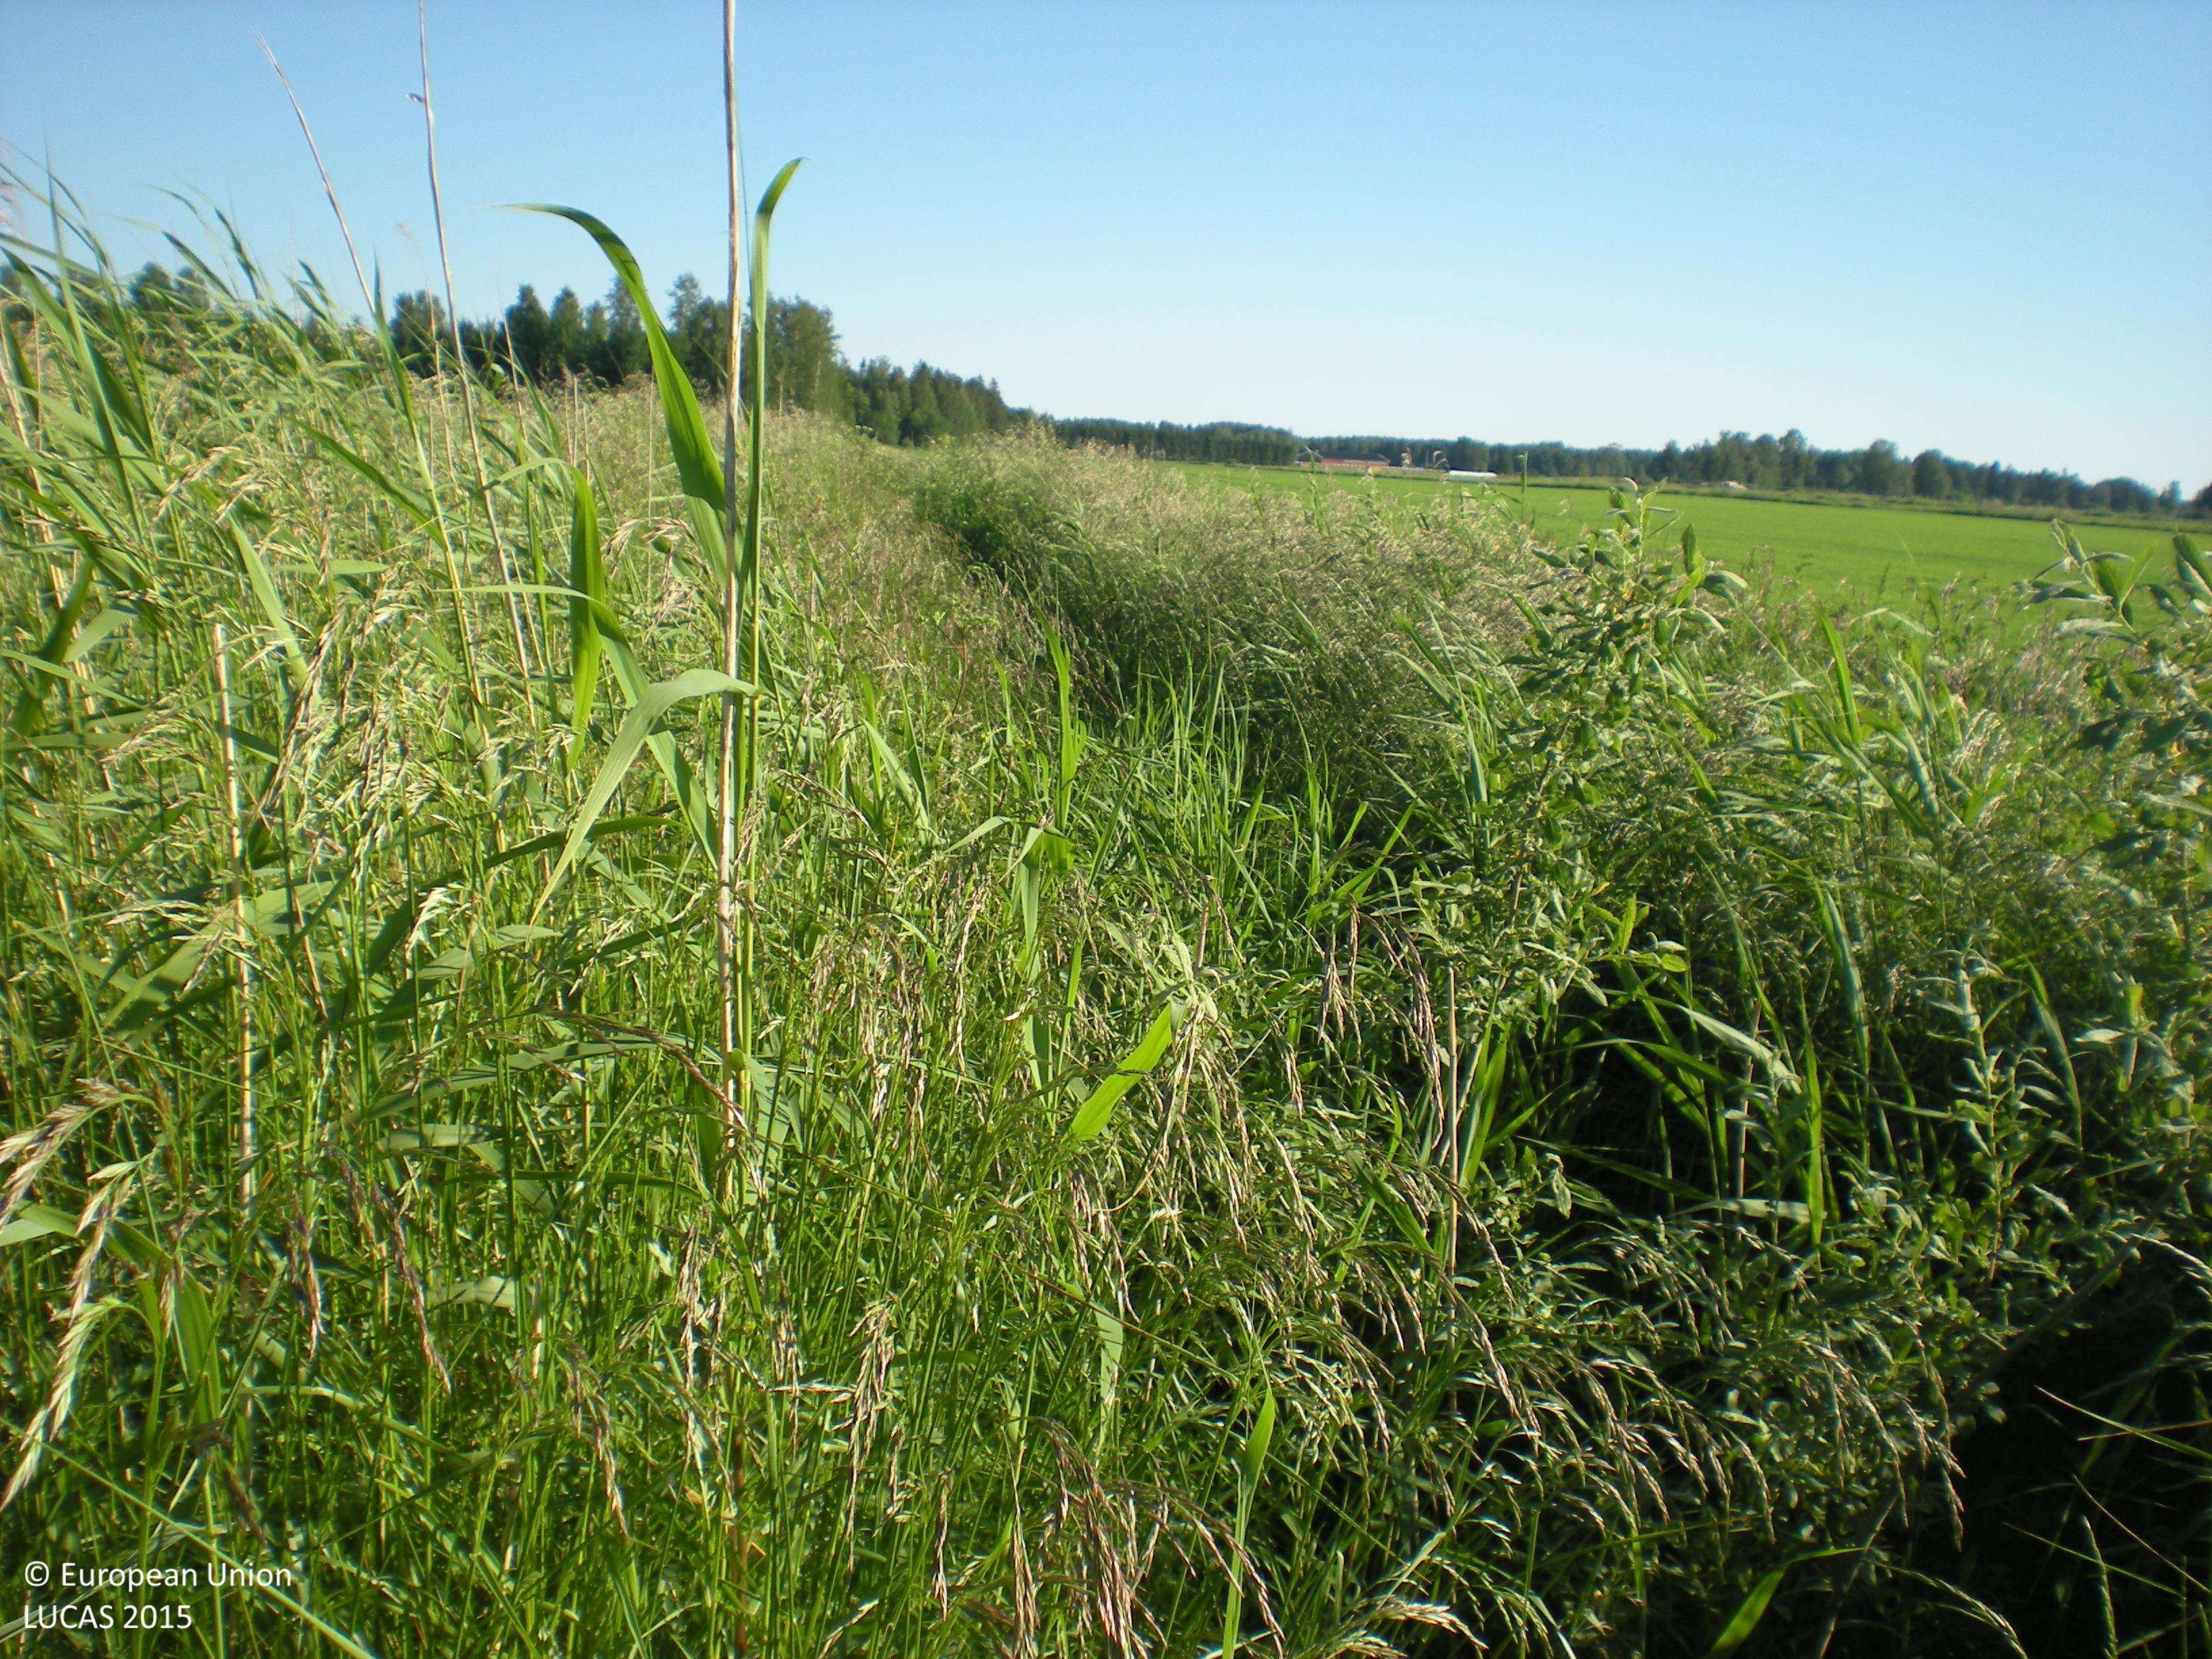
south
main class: Cropland
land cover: Barley
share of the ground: > 75 %
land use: Agriculture (excluding fallow land and kitchen gardens)
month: July
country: SE
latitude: 60.4955
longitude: 17.6914
